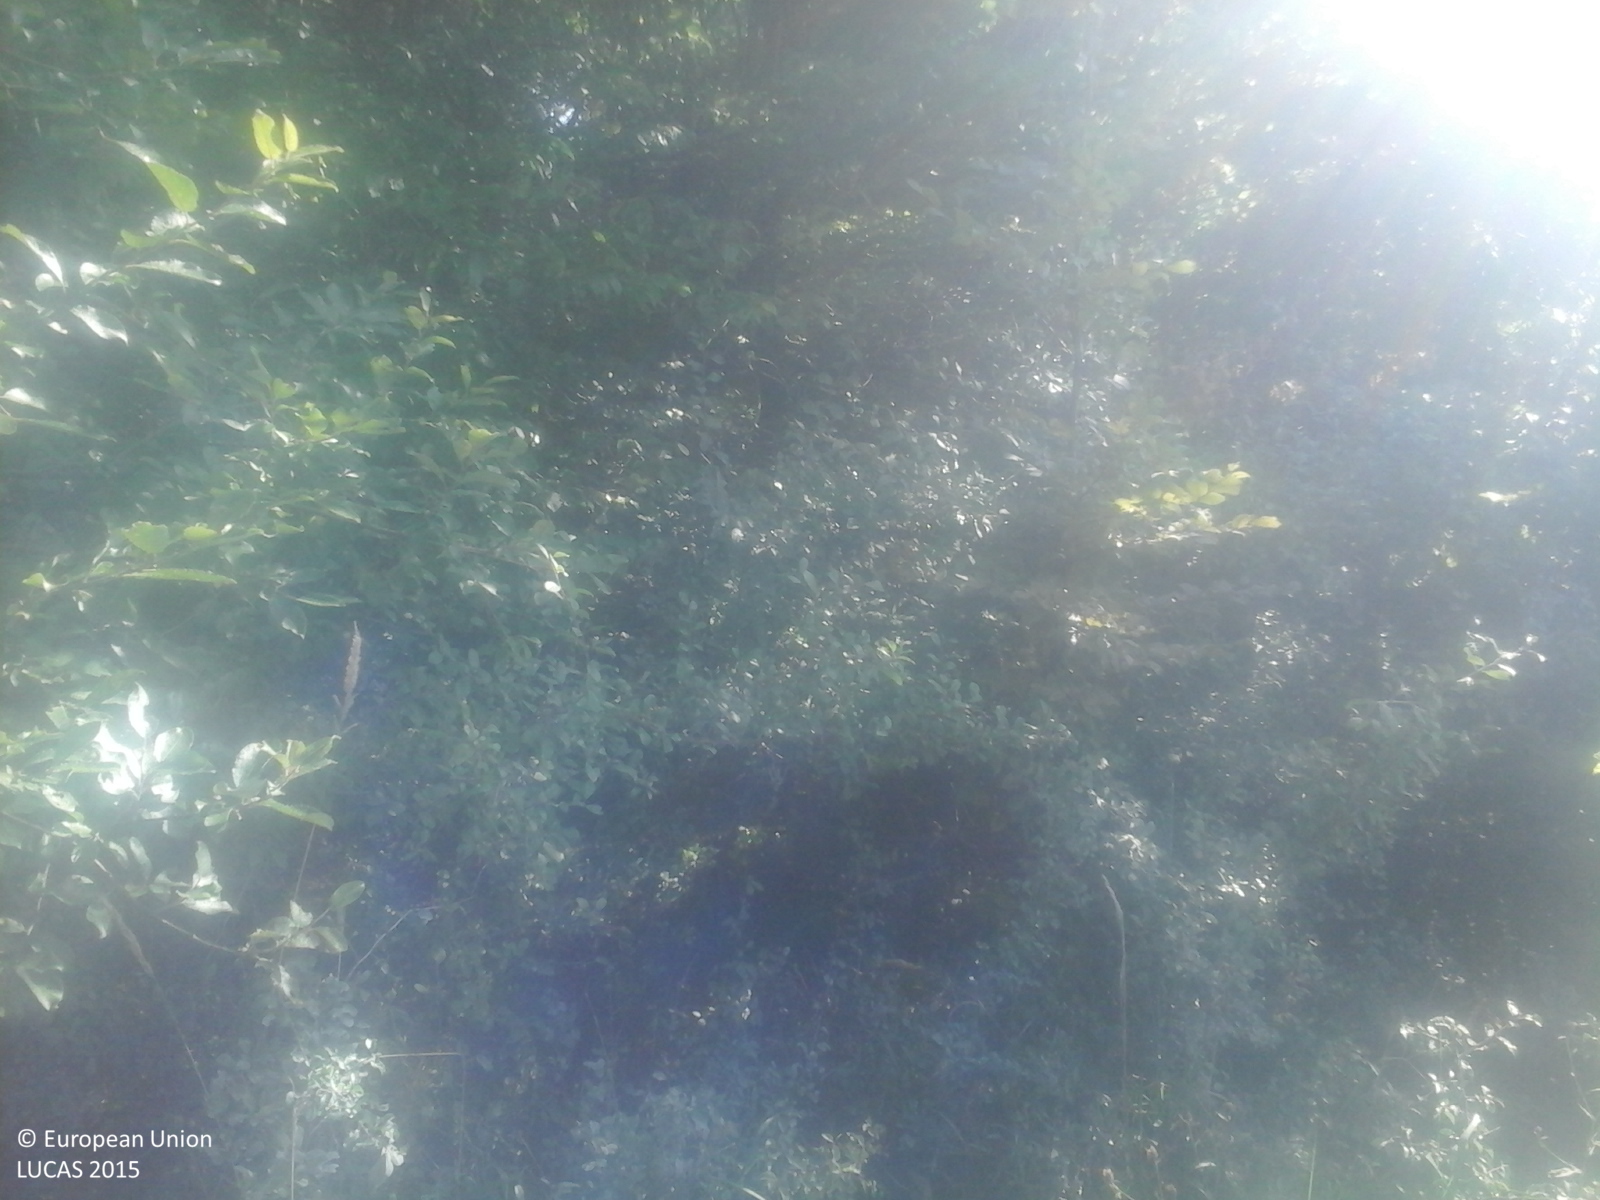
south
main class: Woodland
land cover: Other mixed woodland
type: mesophytic deciduous forest
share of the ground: > 75 %
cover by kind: broadleaved forest trees 70 %, coniferous forest trees 30 %
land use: Forestry
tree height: > 5 m
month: September
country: RO
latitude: 46.9680
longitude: 23.6504
